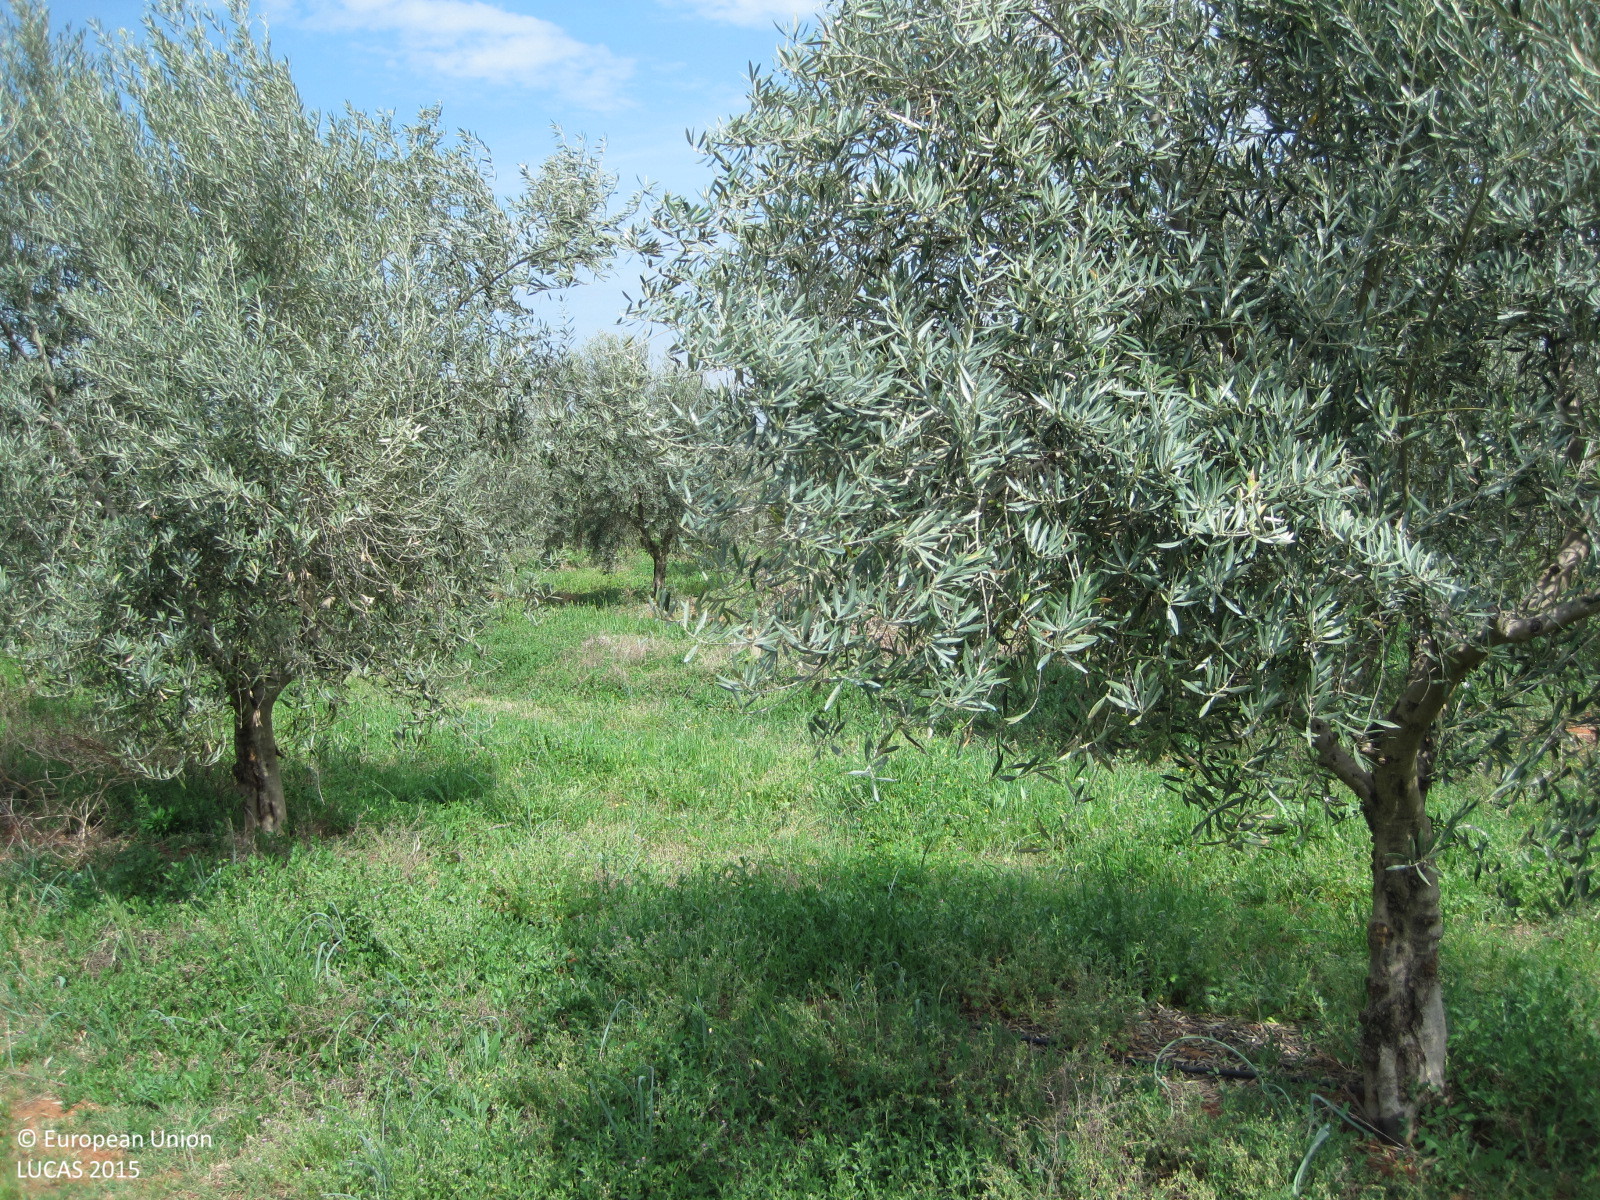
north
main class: Cropland
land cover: Olive groves
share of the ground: 50 - 75 %
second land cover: Spontaneously vegetated surfaces
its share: 25 - 50 %
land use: Agriculture (excluding fallow land and kitchen gardens)
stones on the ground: < 10 %
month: April
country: ES
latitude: 39.8988
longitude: -4.9852
